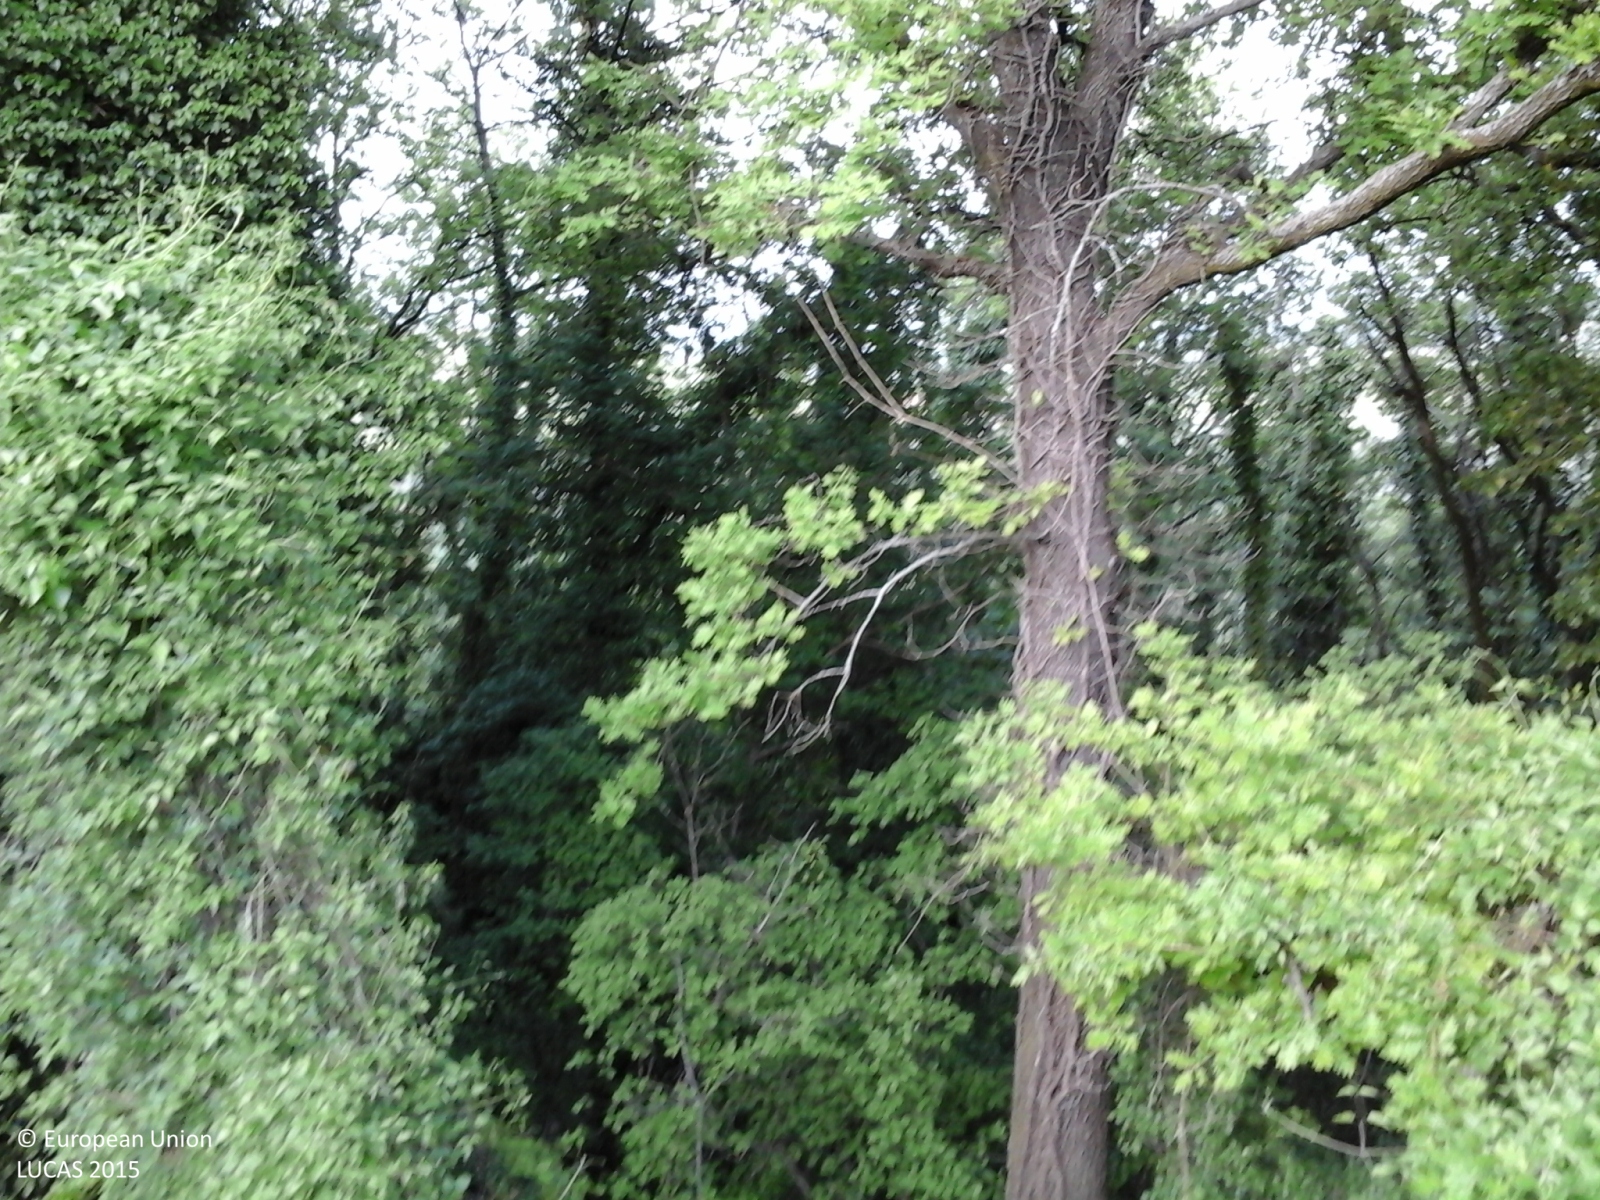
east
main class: Woodland
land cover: Broadleaved woodland
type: mesophytic deciduous forest
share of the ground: > 75 %
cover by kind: broadleaved forest trees 80 %, shrubs 20 %
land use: Forestry
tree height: > 5 m
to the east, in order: Broadleaved woodland; Arable land (only in case pi); Shrubland with sparse tree cover; Grassland with sparse tree/shrub cover; Tracks; Broadleaved woodland
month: April
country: IT
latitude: 44.9081
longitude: 9.4565
